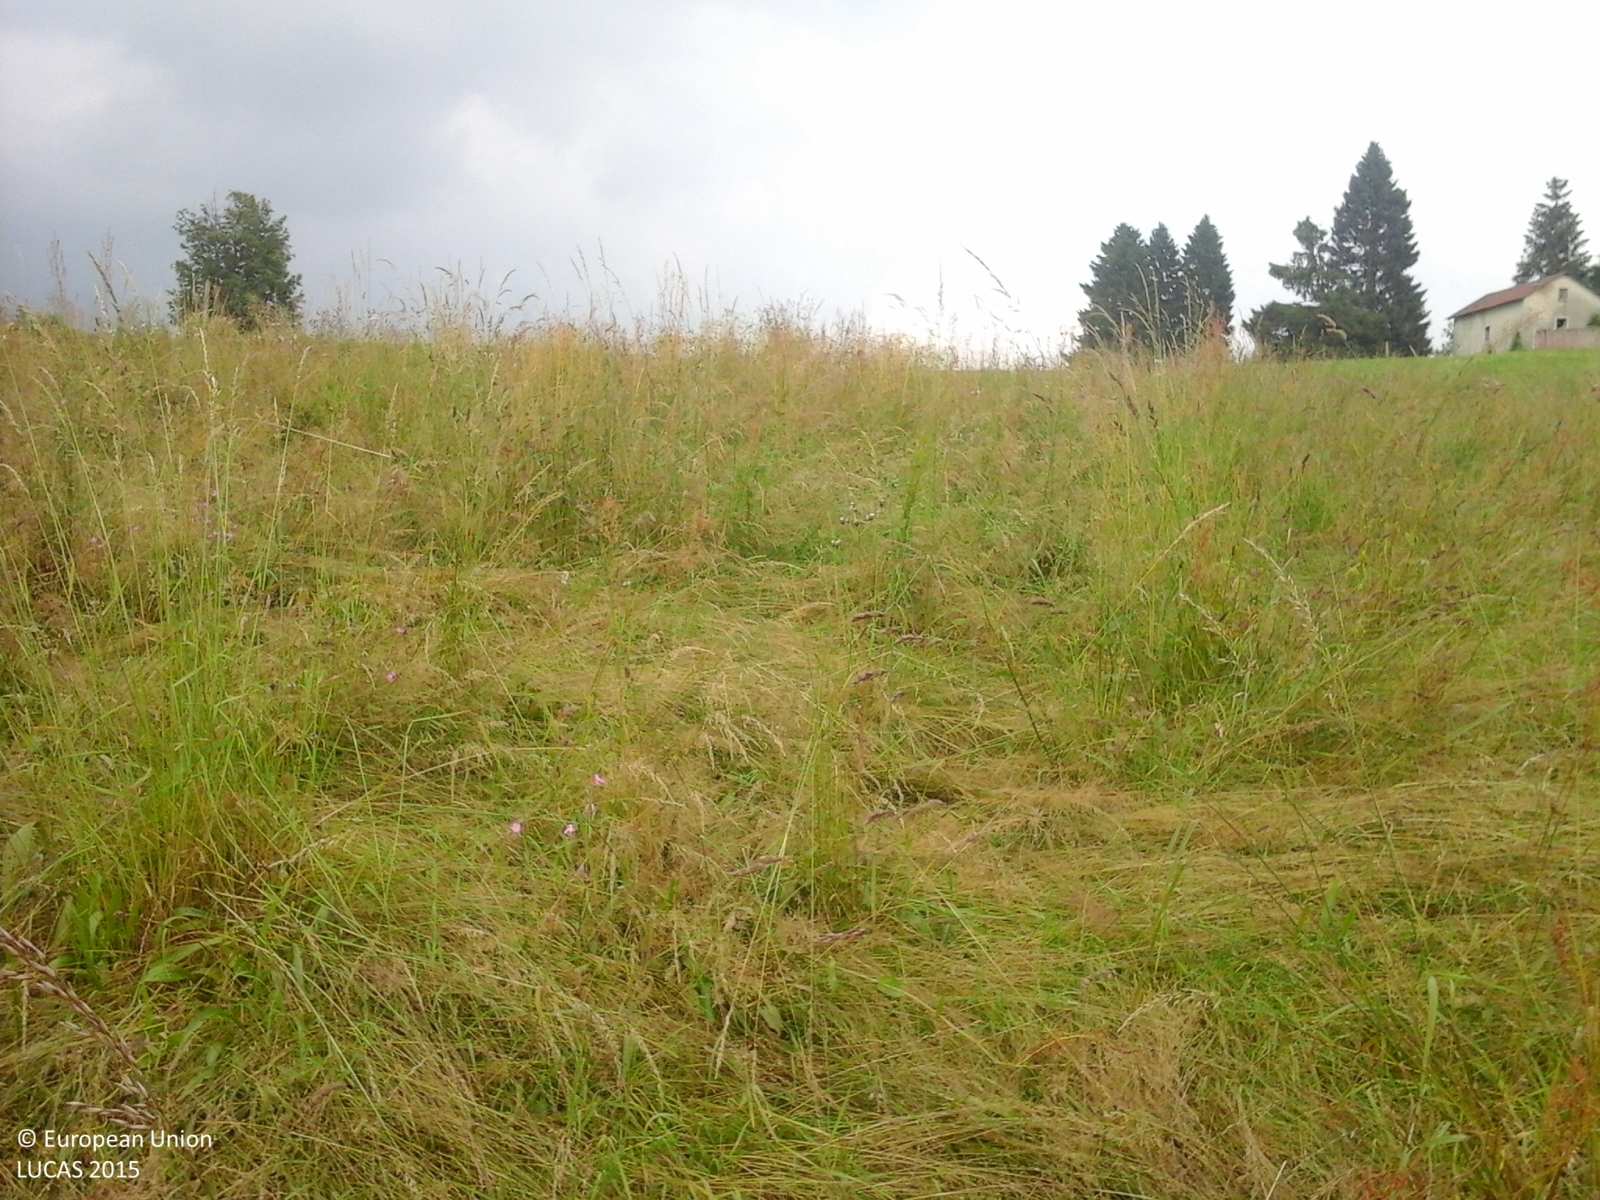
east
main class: Grassland
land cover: Grassland without tree/shrub cover
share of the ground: > 75 %
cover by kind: herbaceous plants 100 %
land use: Agriculture (excluding fallow land and kitchen gardens)
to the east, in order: Grassland without tree/shrub cover; Tracks; Grassland without tree/shrub cover; Artificial constructions in urban areas
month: June
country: IT
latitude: 45.8718
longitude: 11.5308
